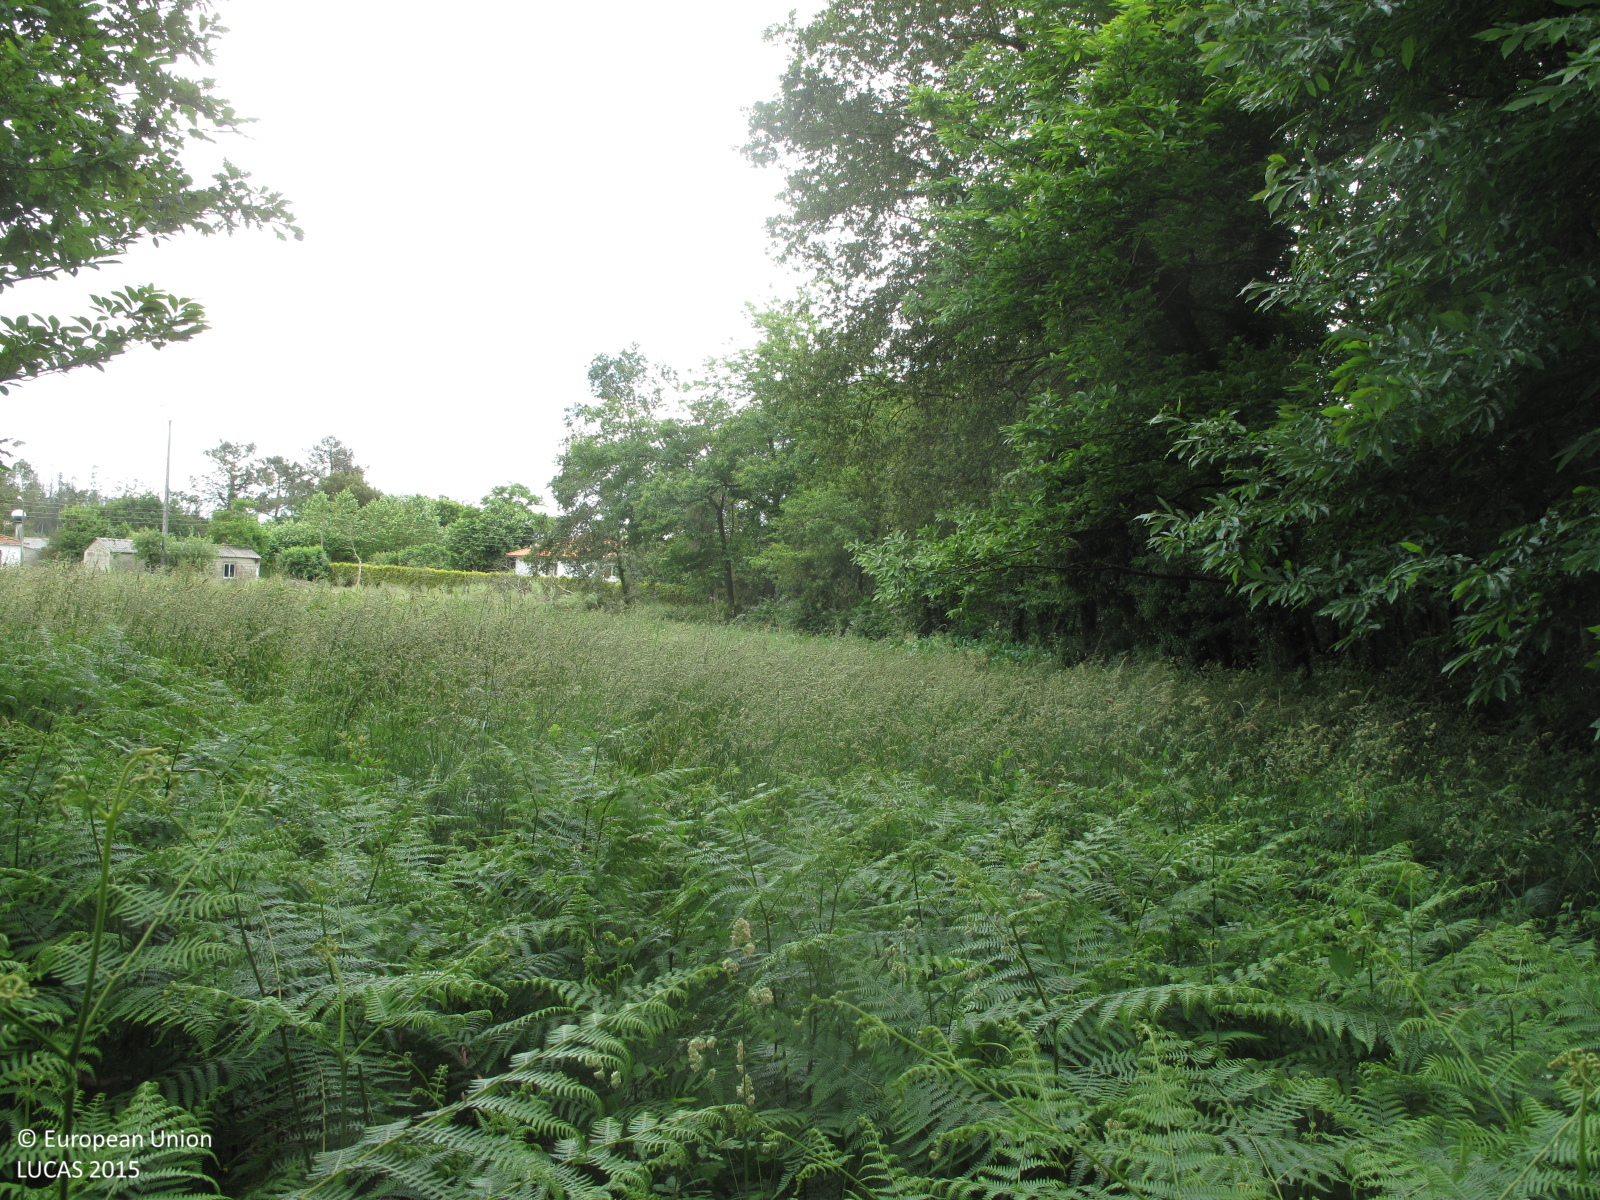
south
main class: Woodland
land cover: Other mixed woodland
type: exotic forest
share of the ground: > 75 %
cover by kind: broadleaved forest trees 40 %, coniferous forest trees 30 %, herbaceous plants 30 %
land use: Forestry
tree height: > 5 m
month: June
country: ES
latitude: 43.0506
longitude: -8.5343
